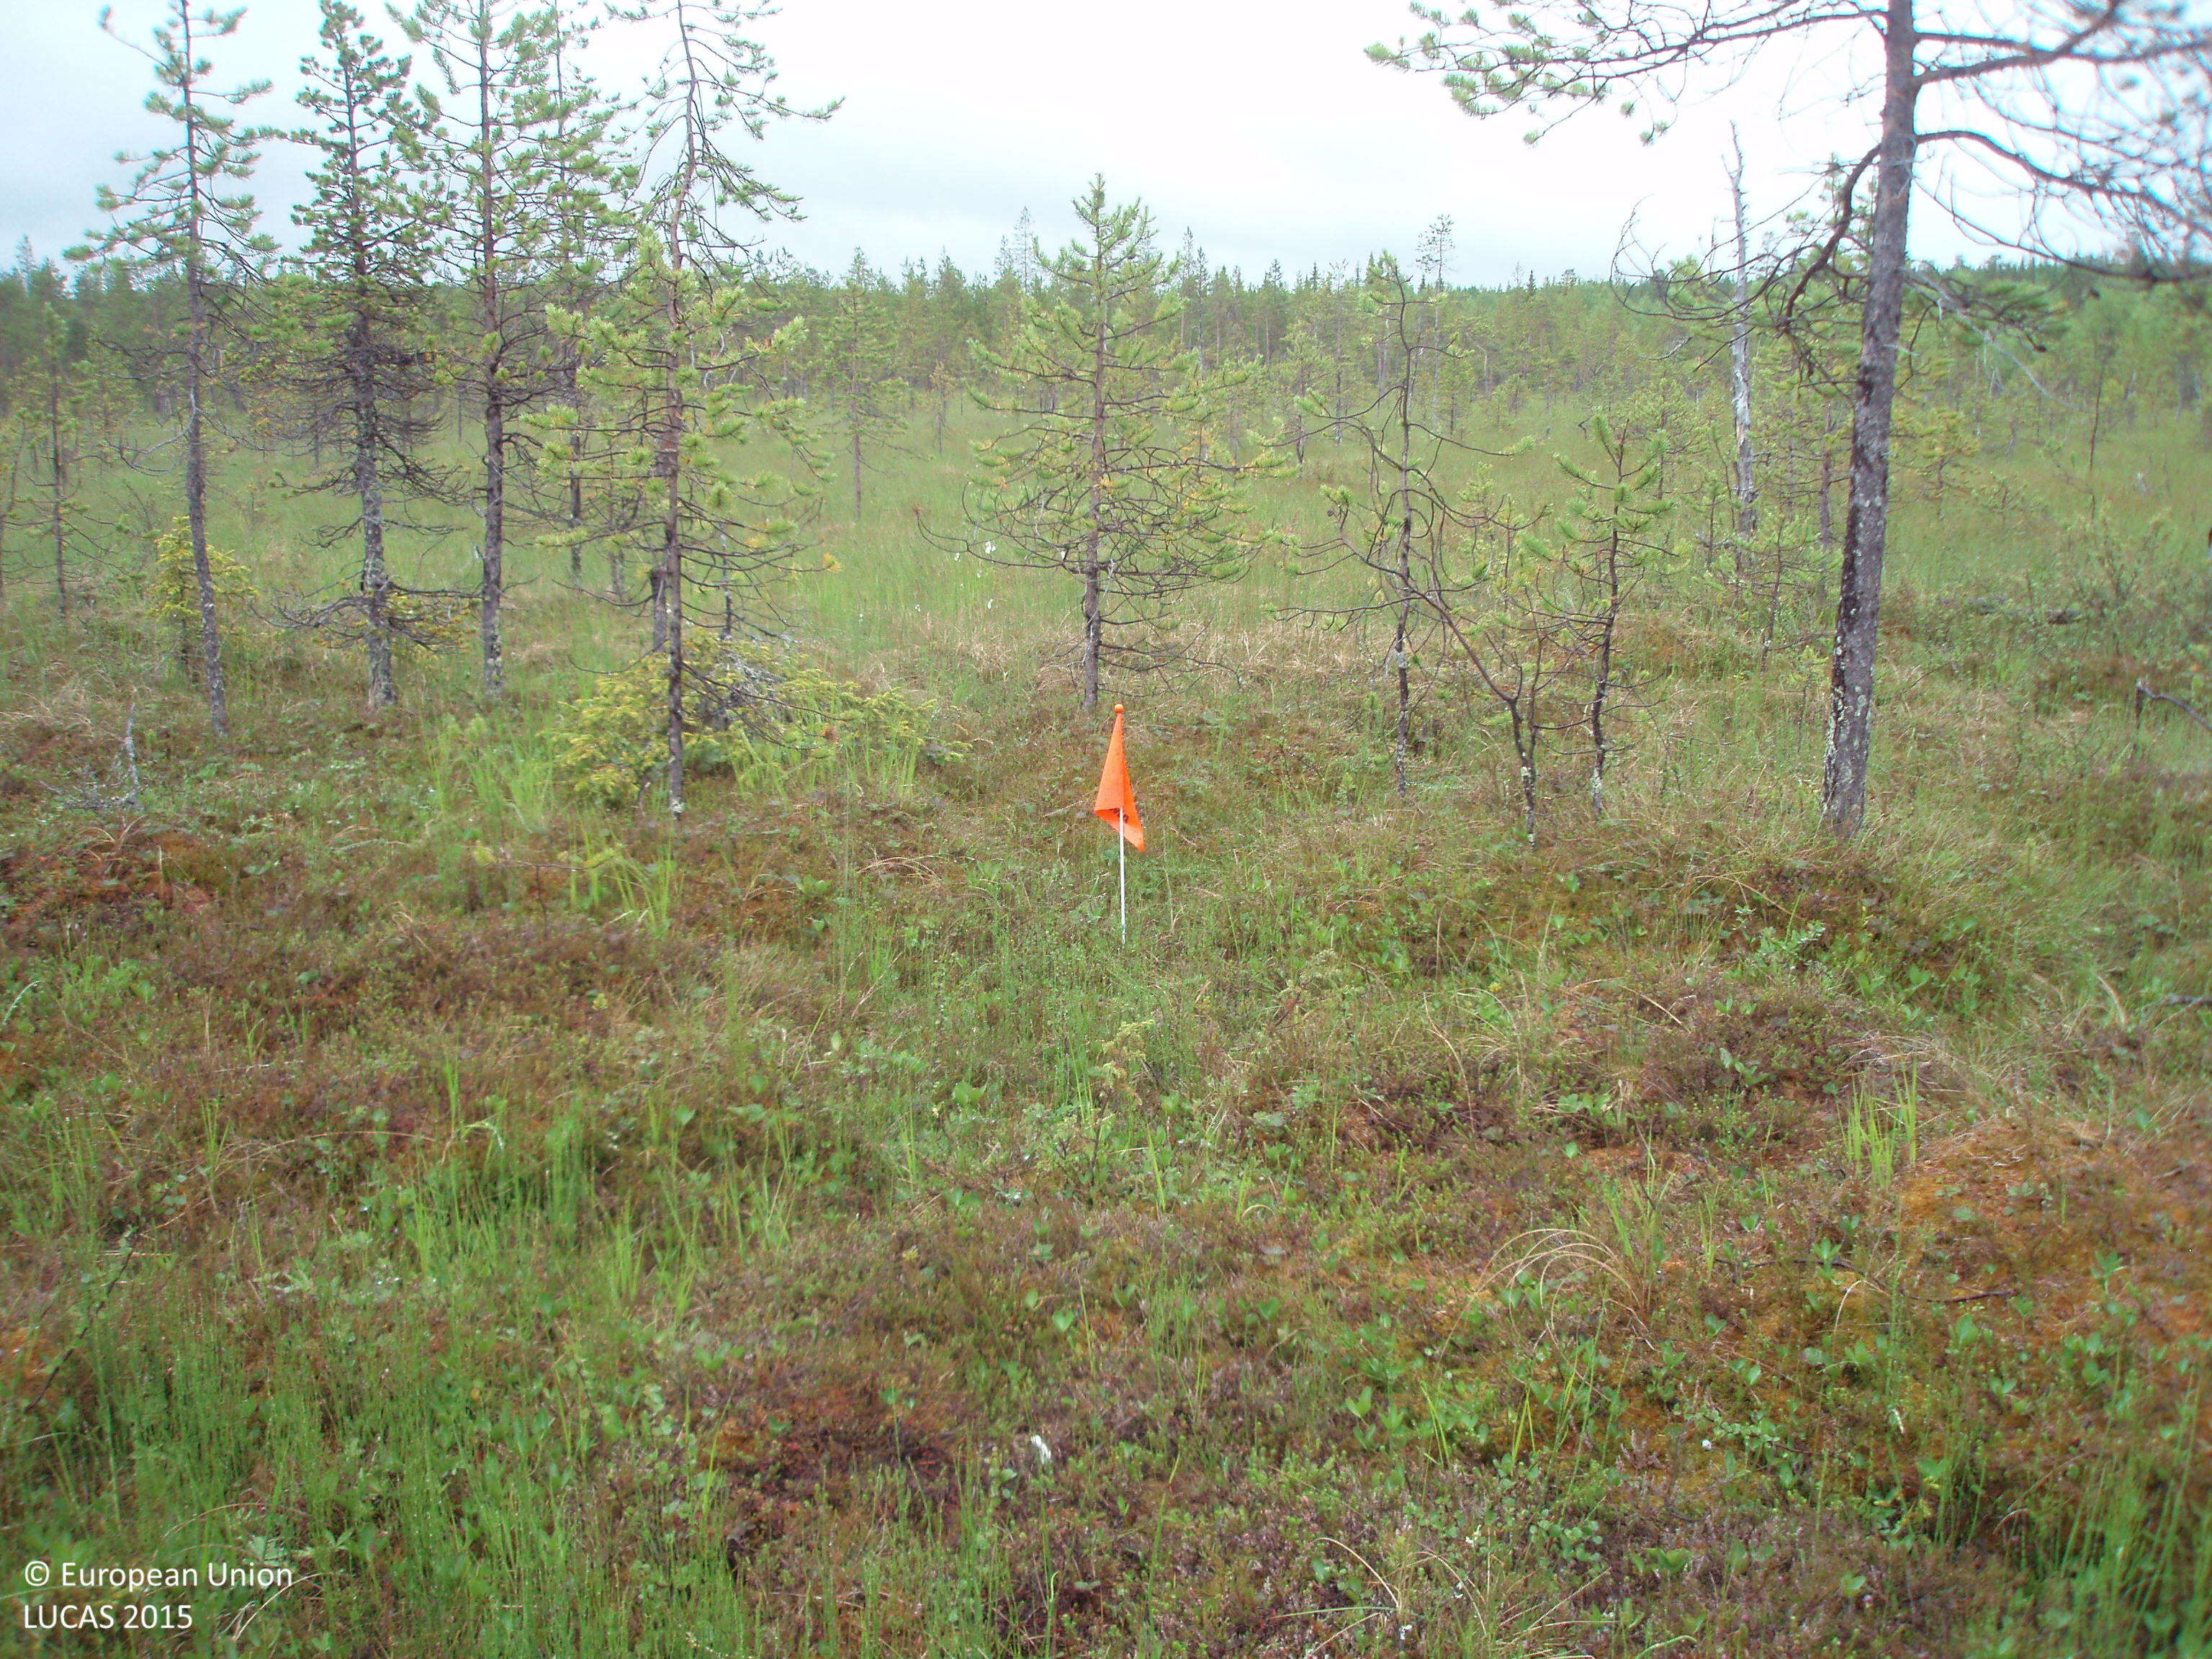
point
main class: Woodland
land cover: Pine dominated coniferous woodland
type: mire and swamp forests
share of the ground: 10 - 25 %
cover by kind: shrubs 45 %, lichens and mosses 35 %, coniferous forest trees 10 %, herbaceous plants 10 %
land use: Semi-natural and natural areas not in use
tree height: > 5 m
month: July
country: FI
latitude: 66.7888
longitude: 28.5369
